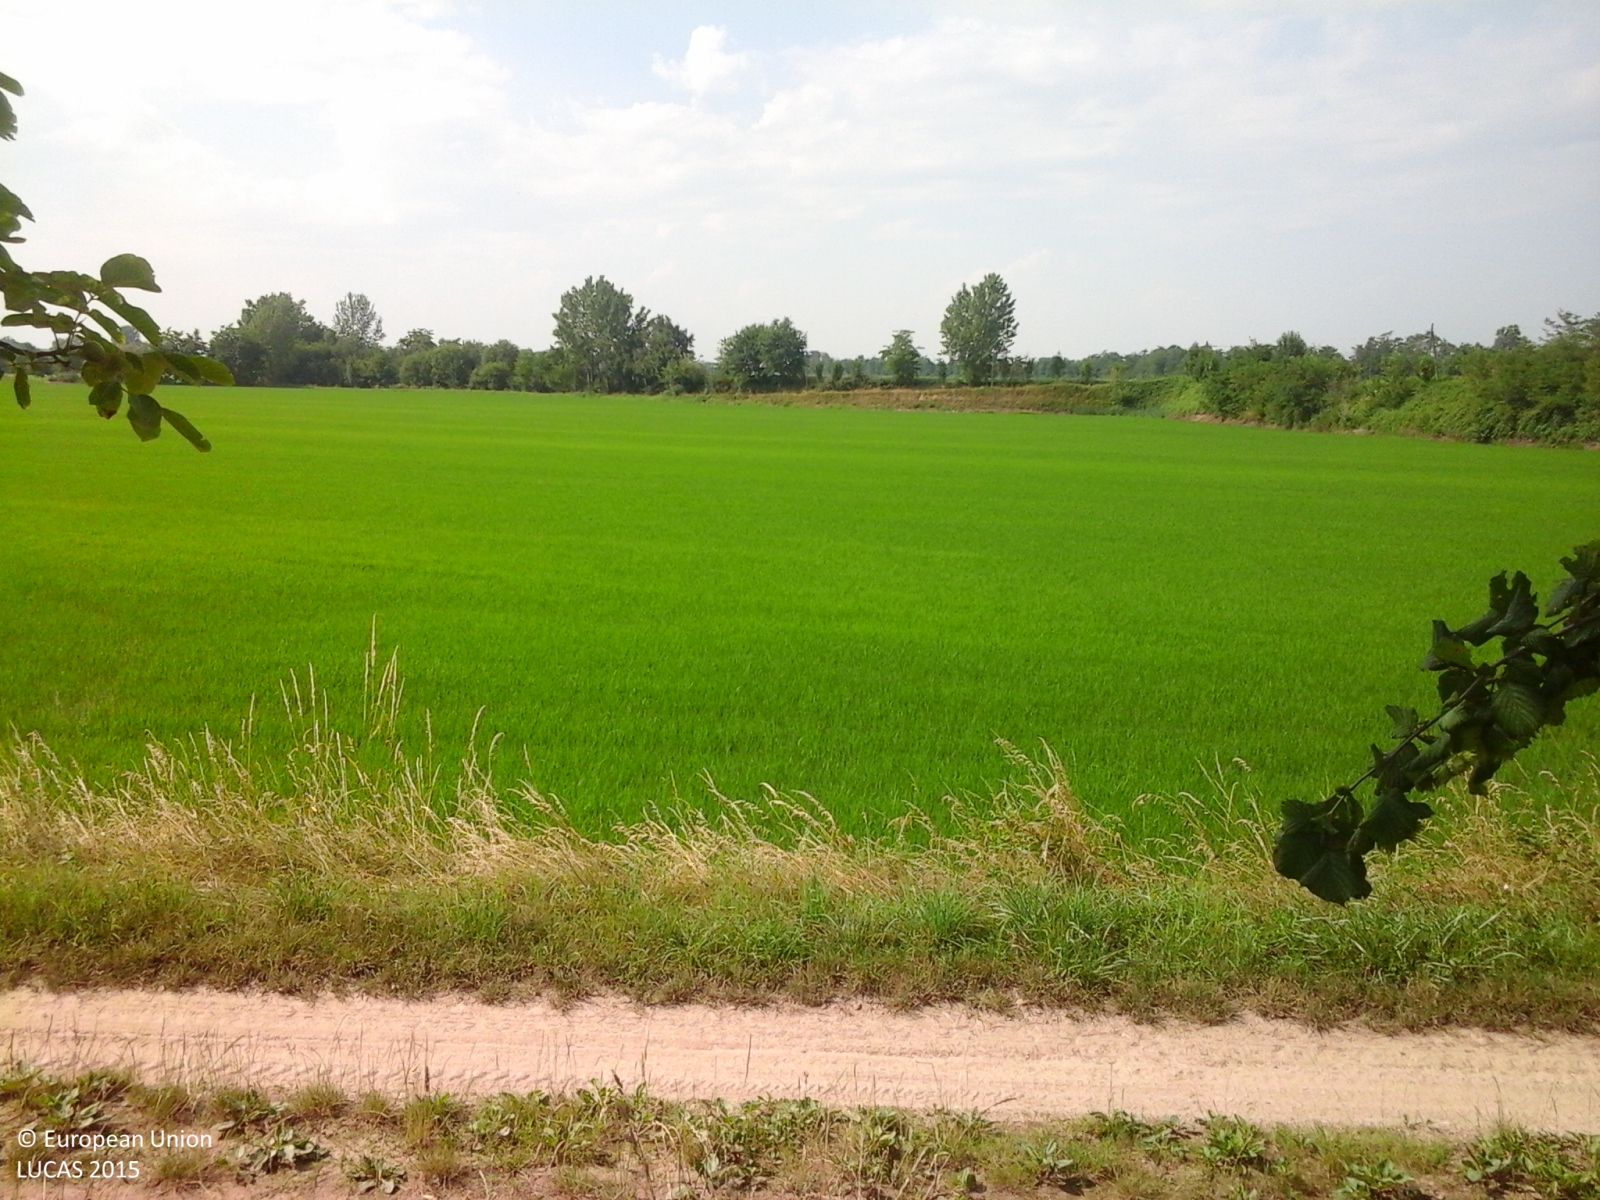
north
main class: Cropland
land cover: Rice
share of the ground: > 75 %
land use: Agriculture (excluding fallow land and kitchen gardens)
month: June
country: IT
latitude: 45.3694
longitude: 8.6362
